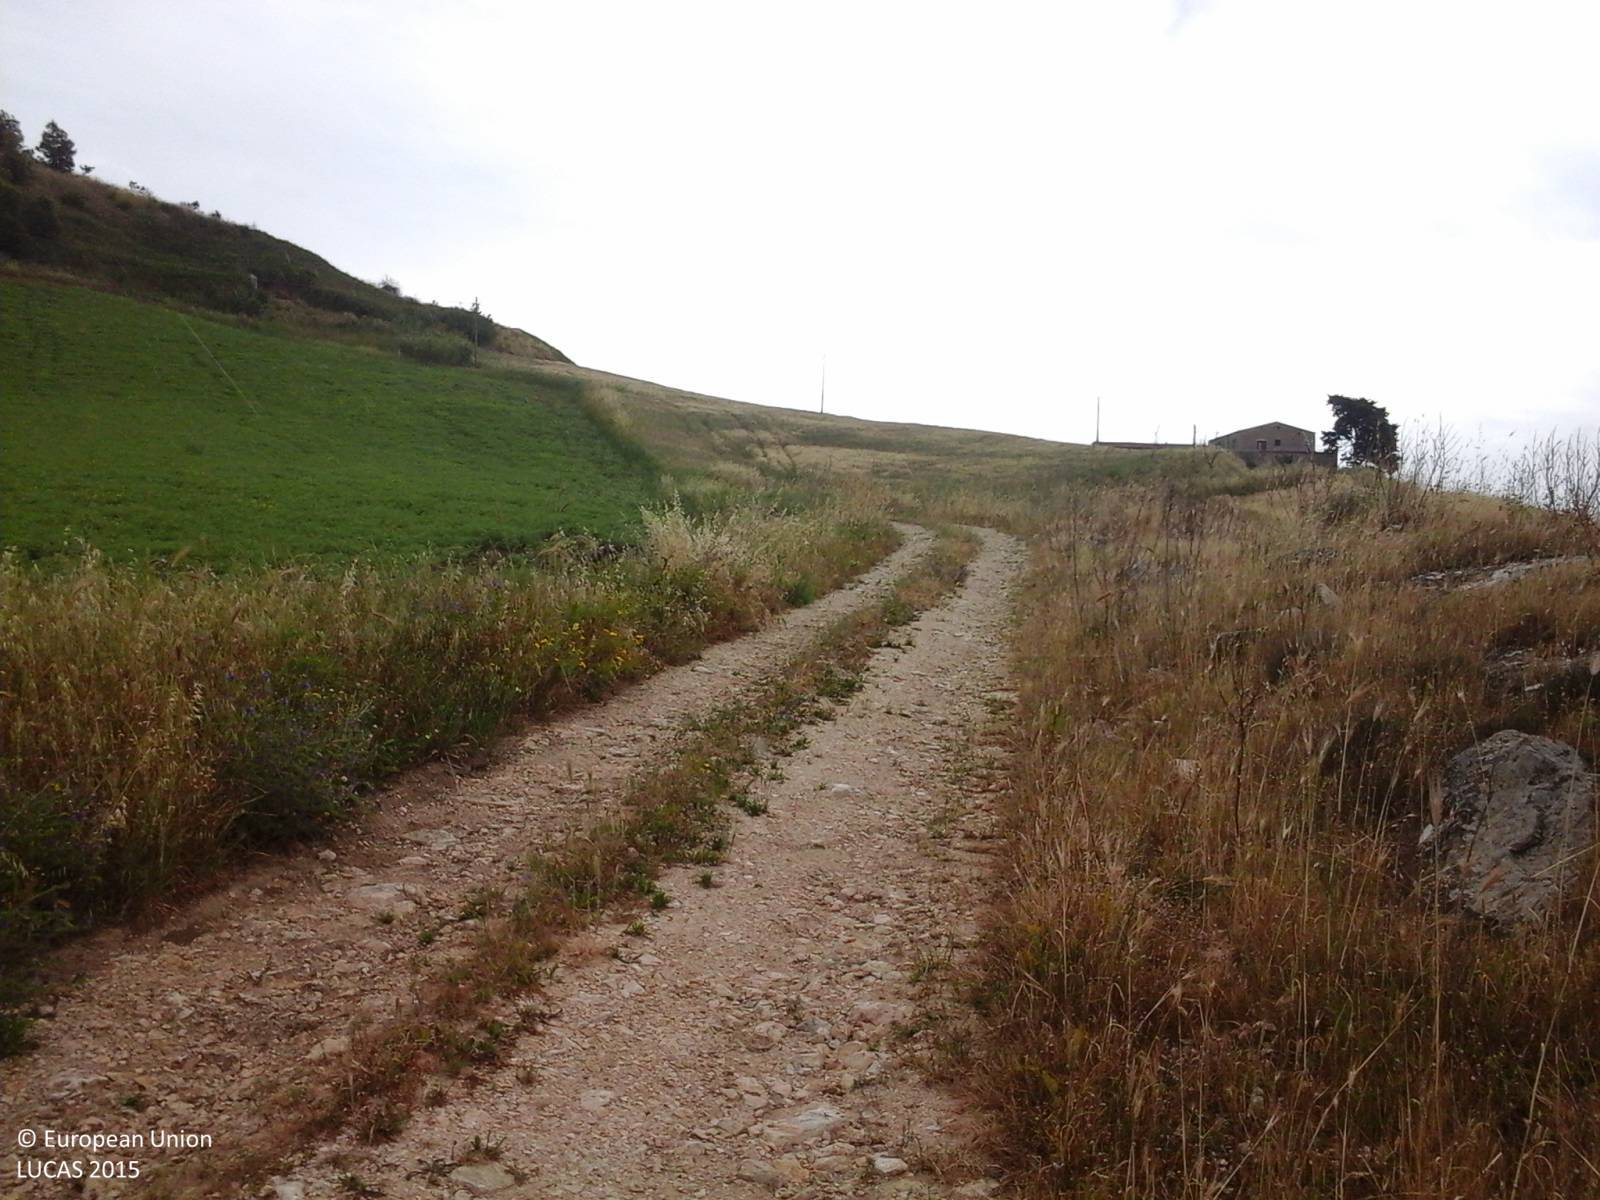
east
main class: Grassland
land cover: Grassland without tree/shrub cover
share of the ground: > 75 %
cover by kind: herbaceous plants 100 %
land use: Agriculture (excluding fallow land and kitchen gardens)
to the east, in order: Grassland without tree/shrub cover; Tracks; Grass margins; Dry pulses; Grass margins; Tracks; Grass margins; Durum wheat; Electric lines; Durum wheat
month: May
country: IT
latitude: 37.8952
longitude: 13.1499
